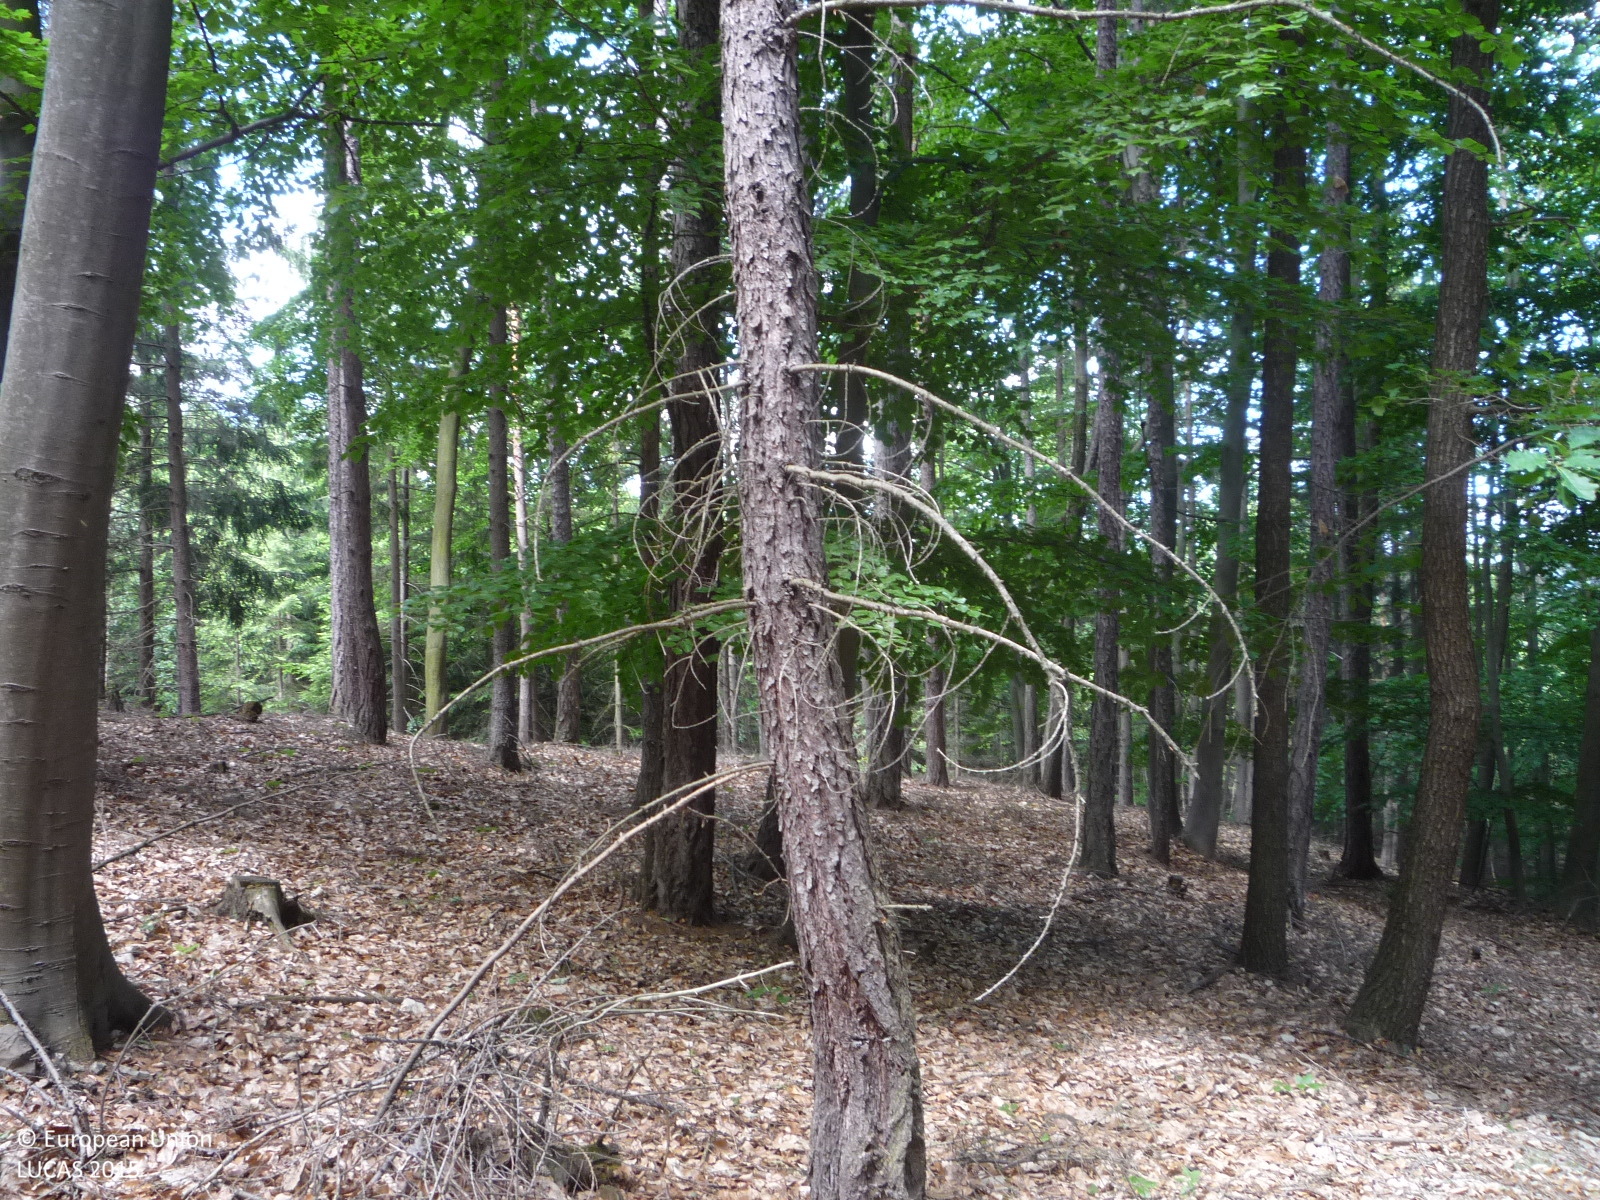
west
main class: Woodland
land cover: Other mixed woodland
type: hemiboreal forest and nemoral coniferous forest and mixed broadleaved-coniferous forest
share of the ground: > 75 %
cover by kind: coniferous forest trees 60 %, broadleaved forest trees 30 %, herbaceous plants 5 %, unconsolidated bare surface 5 %
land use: Forestry
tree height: > 5 m
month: June
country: CZ
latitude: 50.2092
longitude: 13.8541
